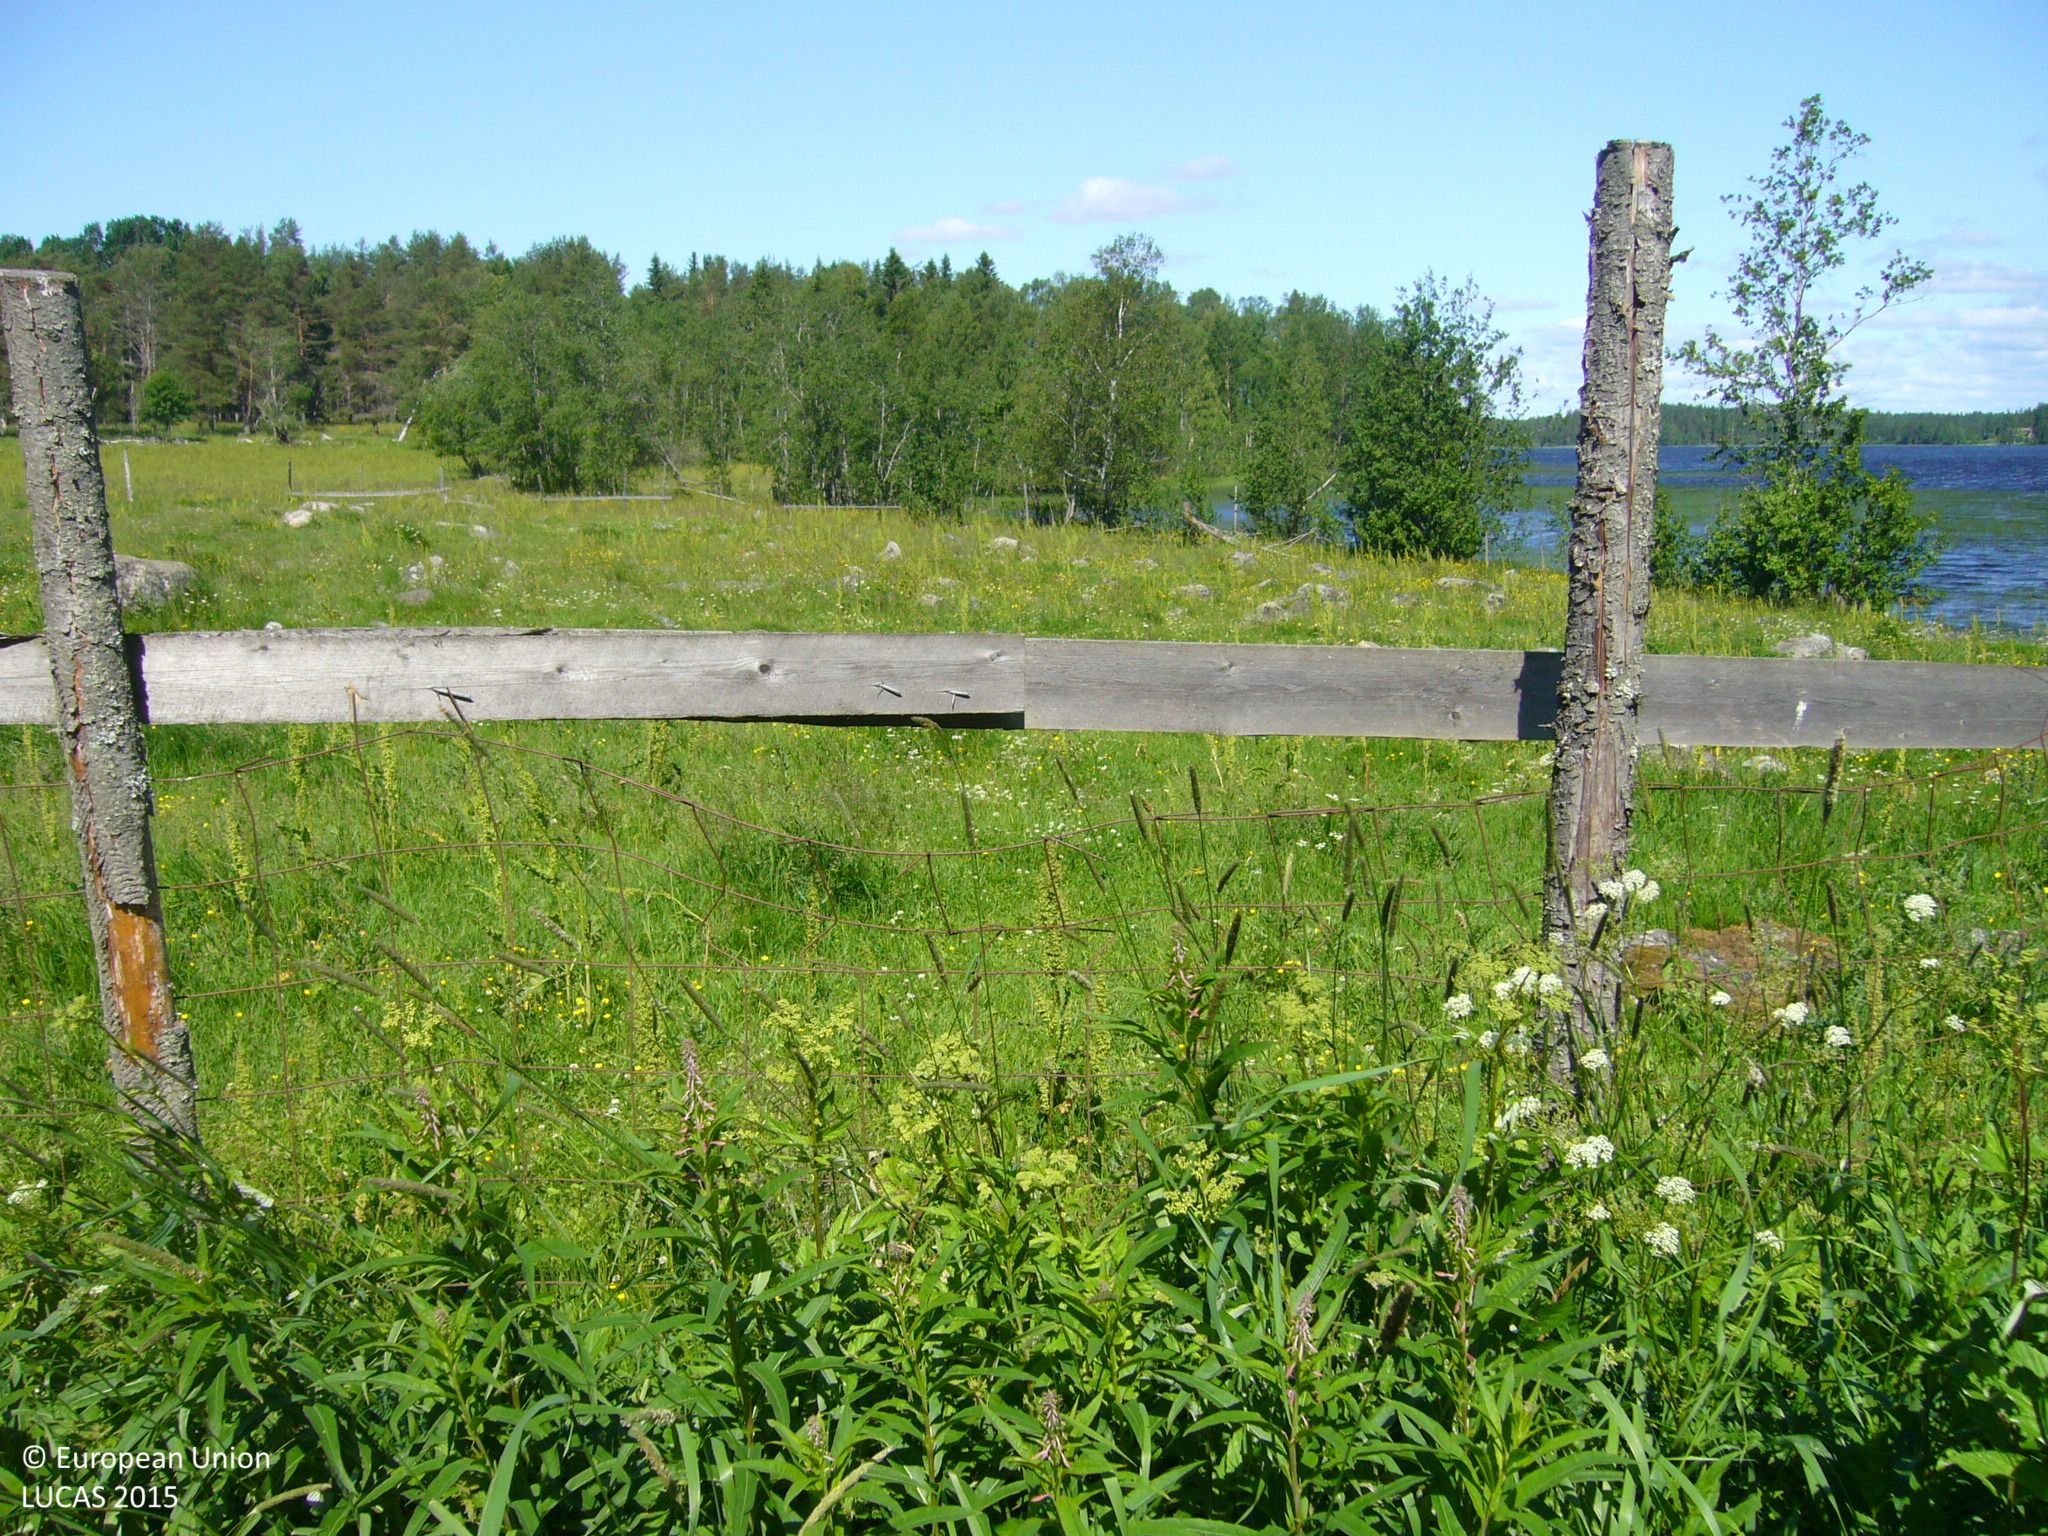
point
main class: Grassland
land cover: Grassland without tree/shrub cover
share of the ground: > 75 %
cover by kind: herbaceous plants 100 %
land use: Agriculture (excluding fallow land and kitchen gardens)
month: July
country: FI
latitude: 63.3310
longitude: 26.2373
